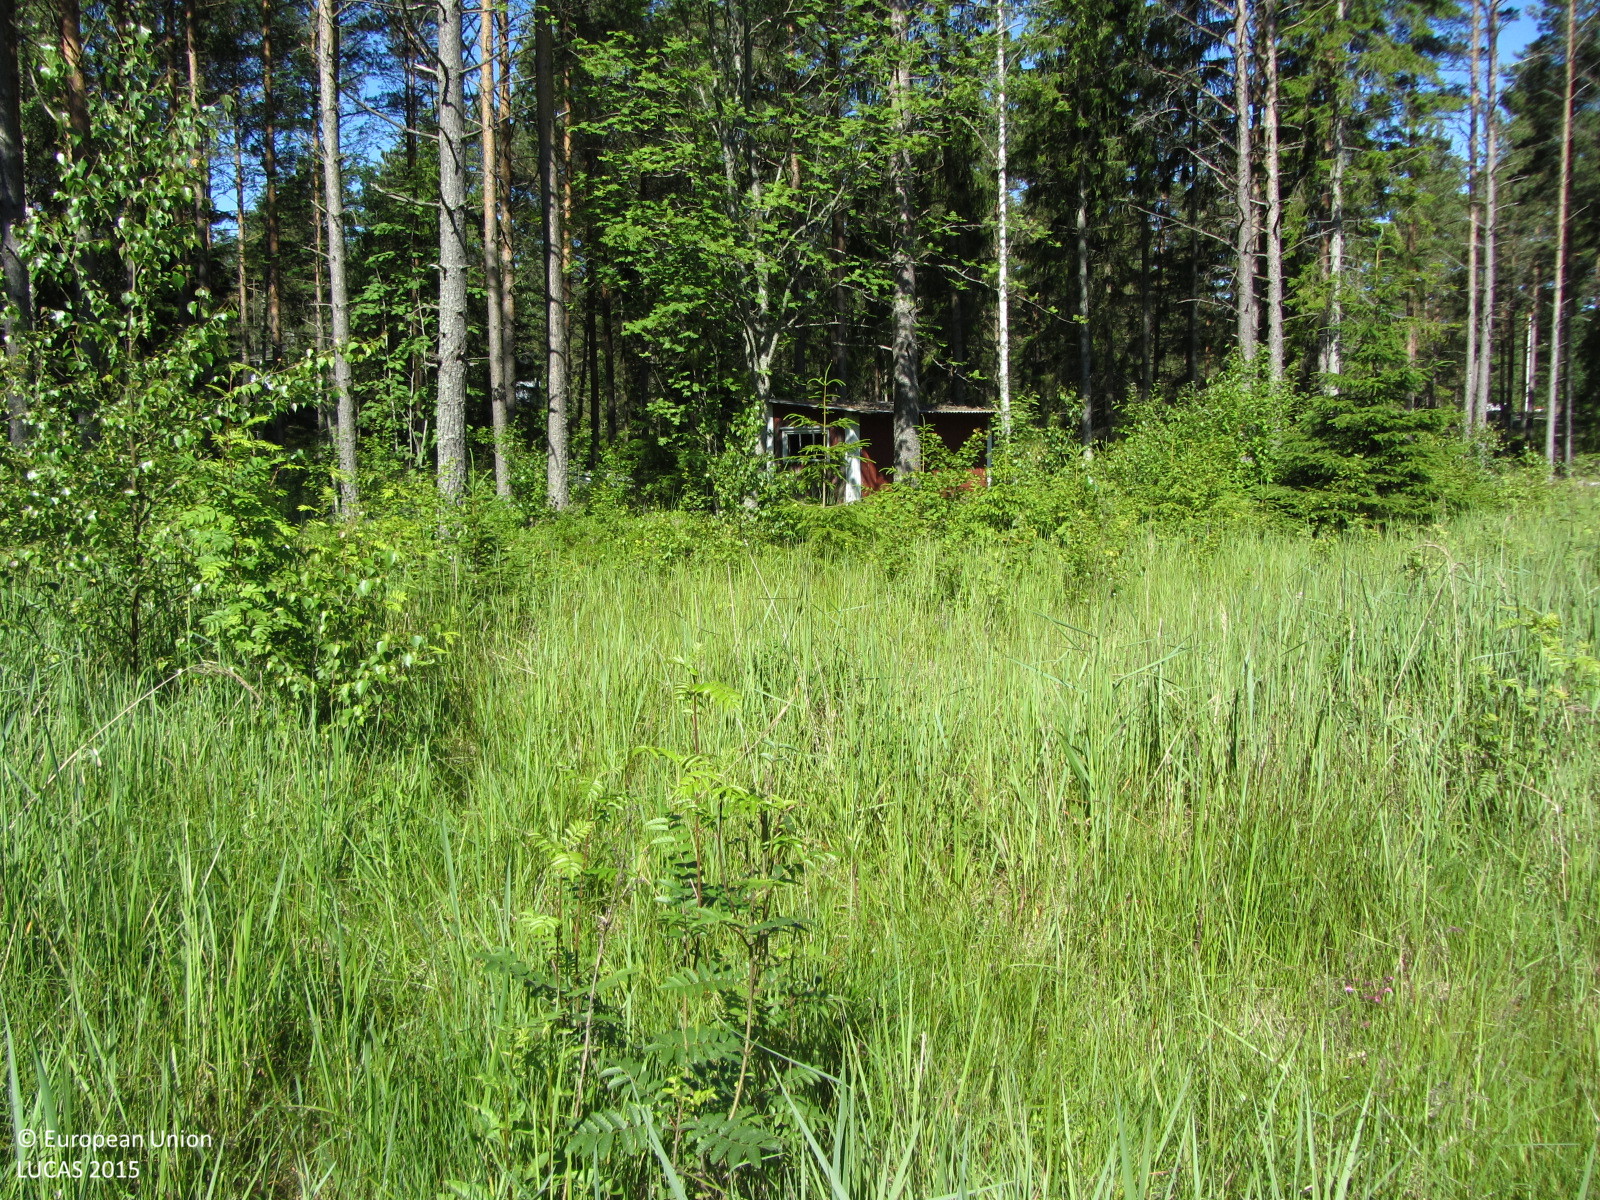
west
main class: Grassland
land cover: Grassland with sparse tree/shrub cover
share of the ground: > 75 %
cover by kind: herbaceous plants 90 %, broadleaved forest trees 5 %, shrubs 5 %
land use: Residential
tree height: < 5 m
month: July
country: FI
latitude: 59.8412
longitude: 23.0926
